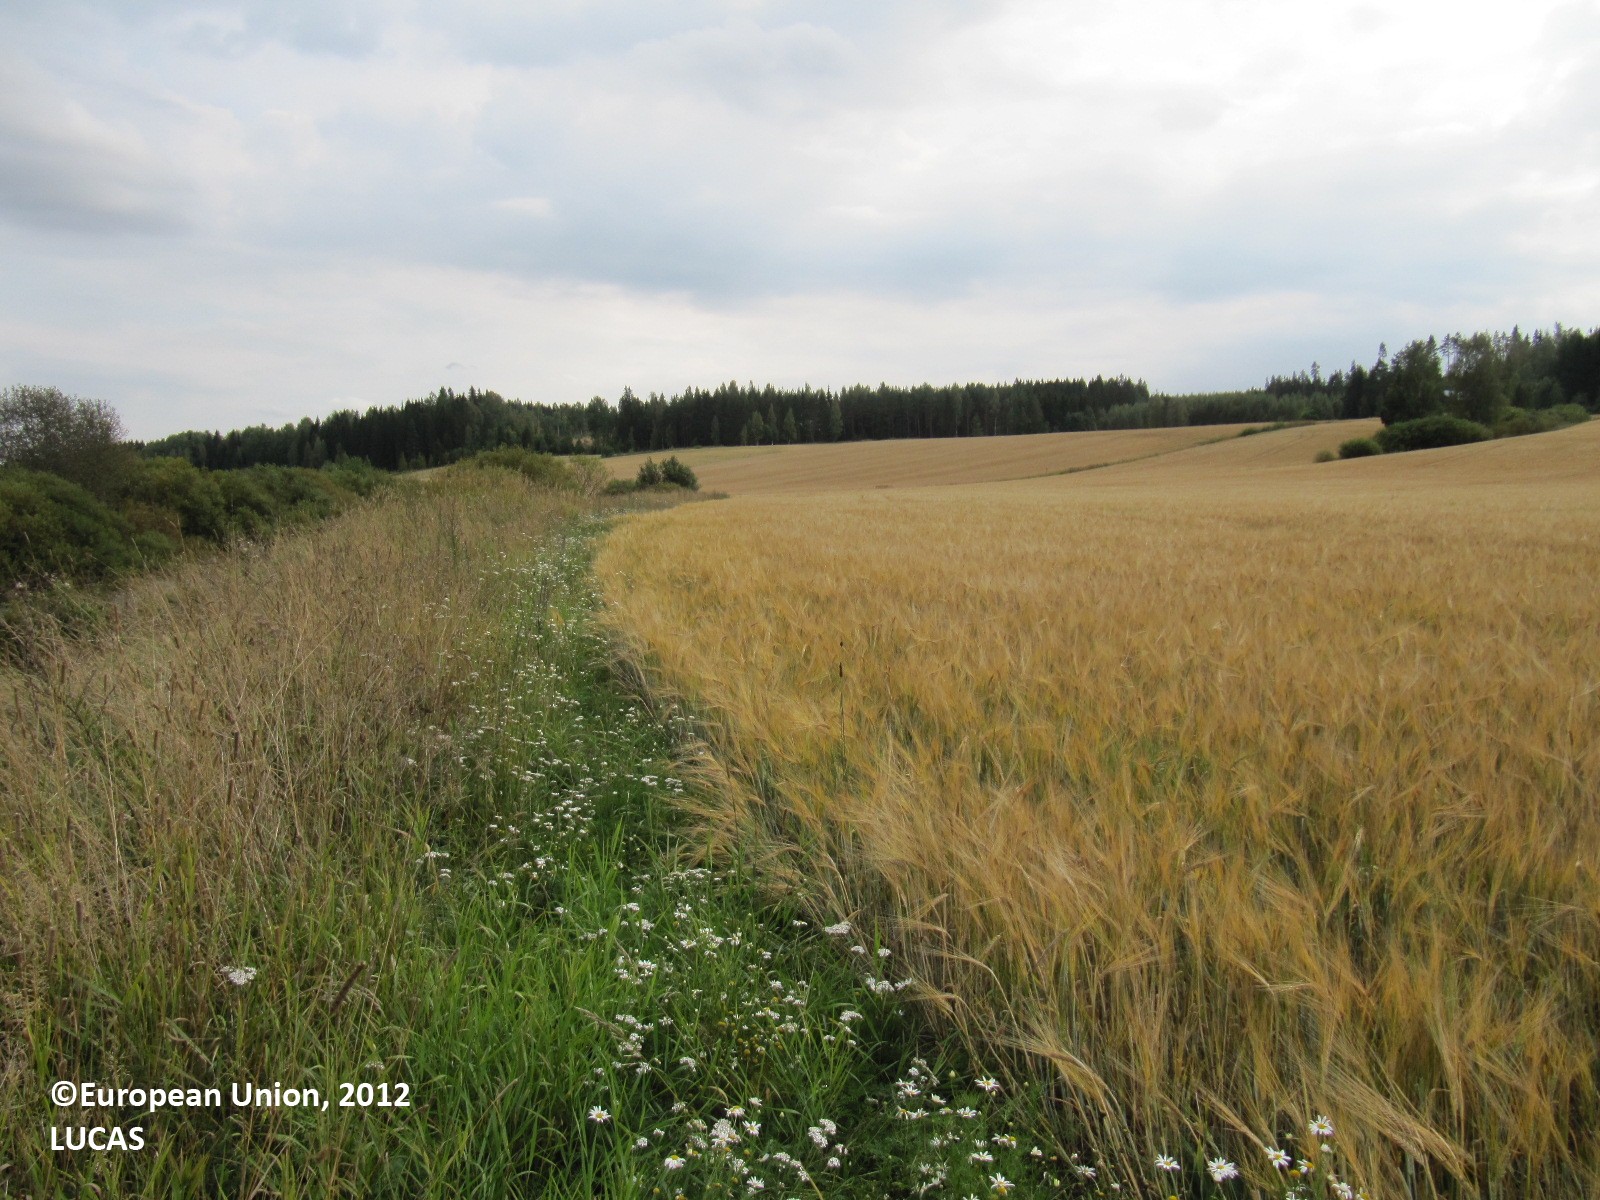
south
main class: Grassland
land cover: Grassland with sparse tree/shrub cover
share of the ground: > 75 %
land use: Agriculture (excluding fallow land and kitchen gardens)
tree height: < 5 m
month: August
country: FI
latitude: 61.1323
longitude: 22.9782
